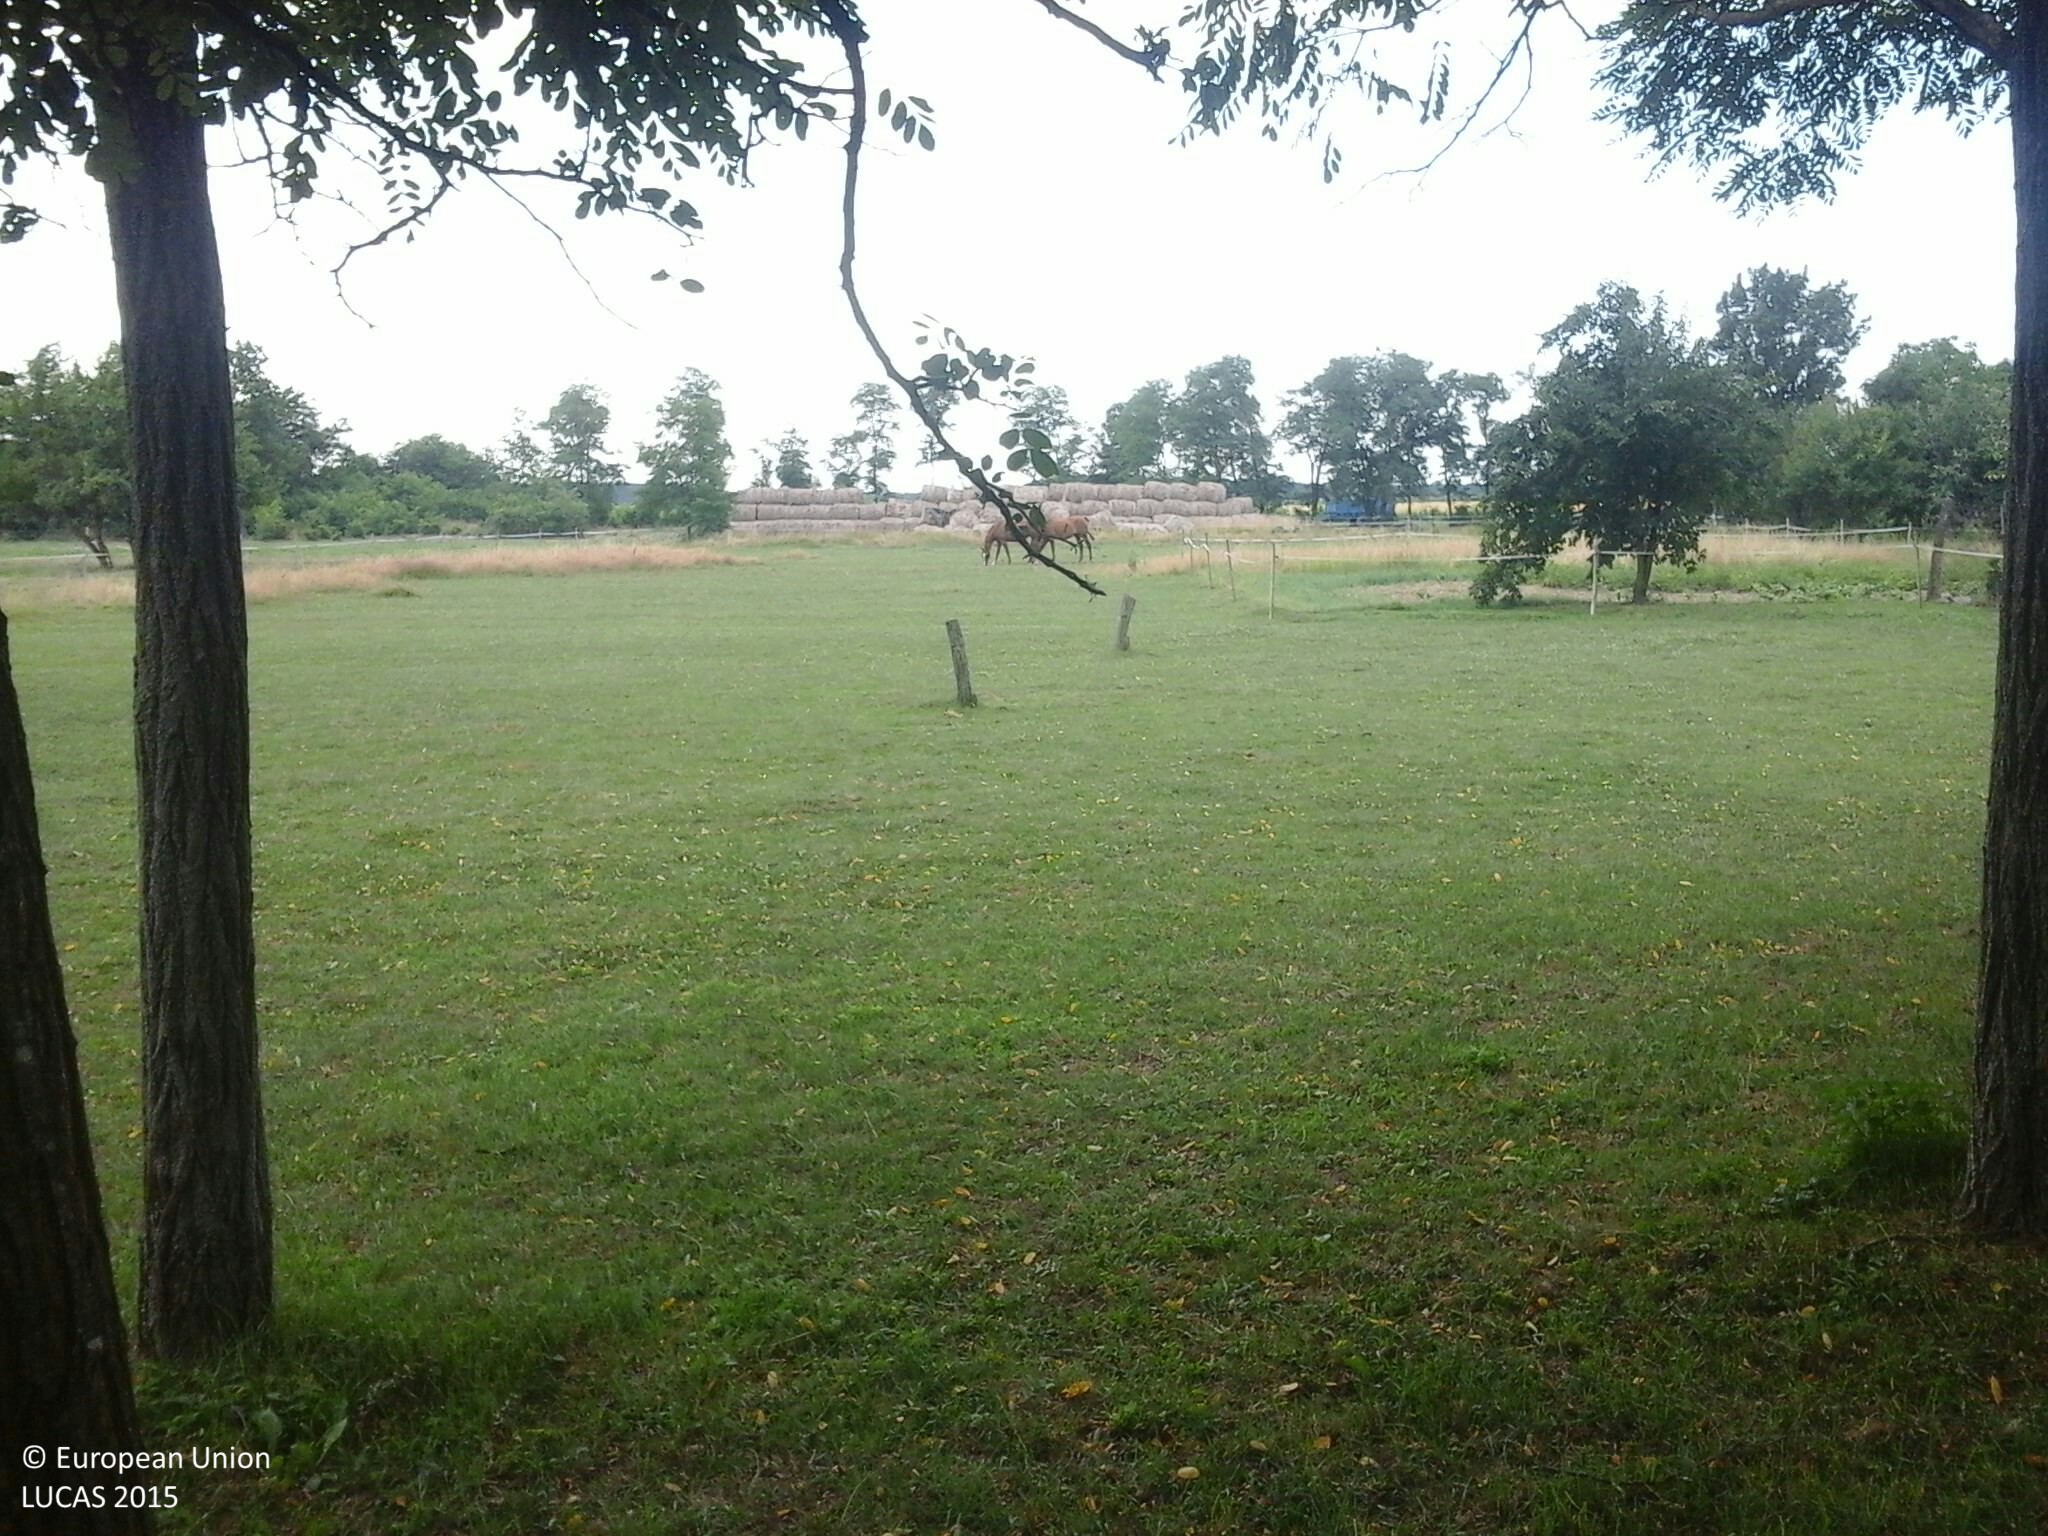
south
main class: Woodland
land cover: Broadleaved woodland
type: exotic forest
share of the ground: 50 - 75 %
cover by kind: herbaceous plants 60 %, broadleaved forest trees 40 %
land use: Residential
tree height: > 5 m
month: July
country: HU
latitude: 47.0702
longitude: 16.5740
